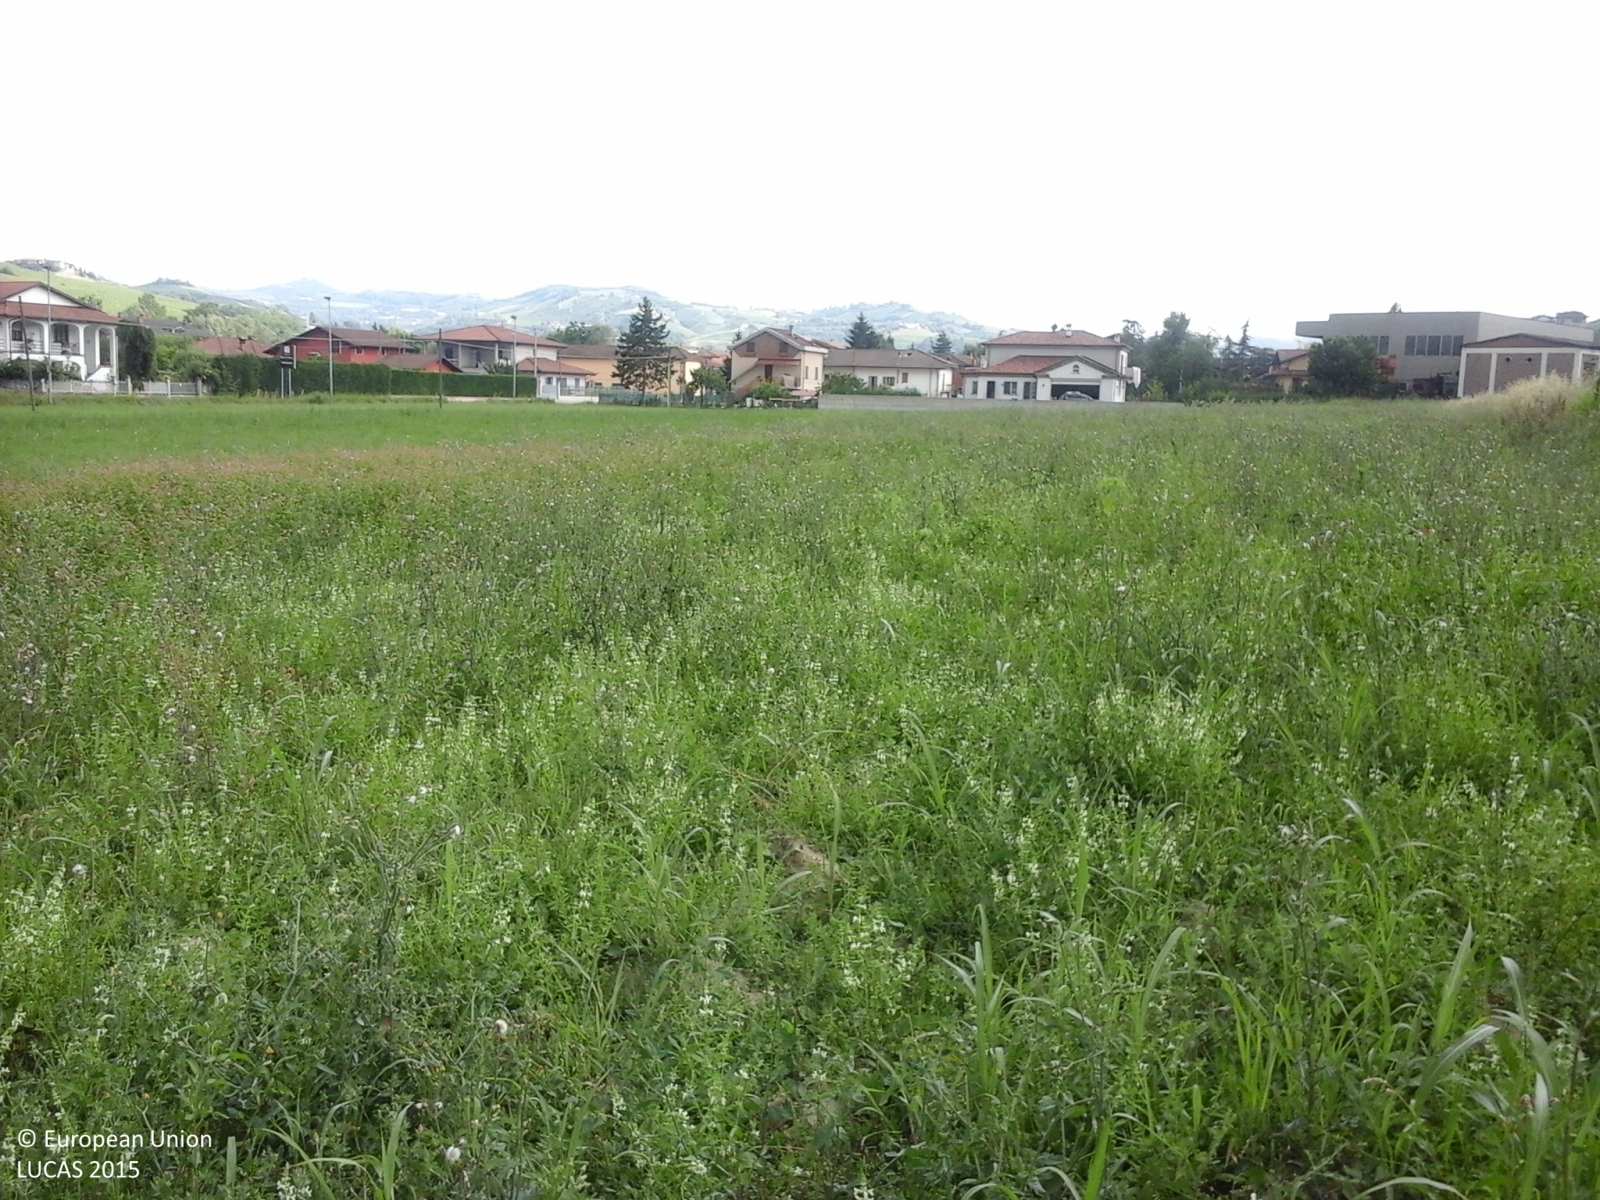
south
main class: Grassland
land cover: Spontaneously vegetated surfaces
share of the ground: > 75 %
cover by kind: herbaceous plants 90 %, consolidated bare surface 10 %
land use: Fallow land
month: June
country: IT
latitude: 44.7304
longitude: 8.1224
